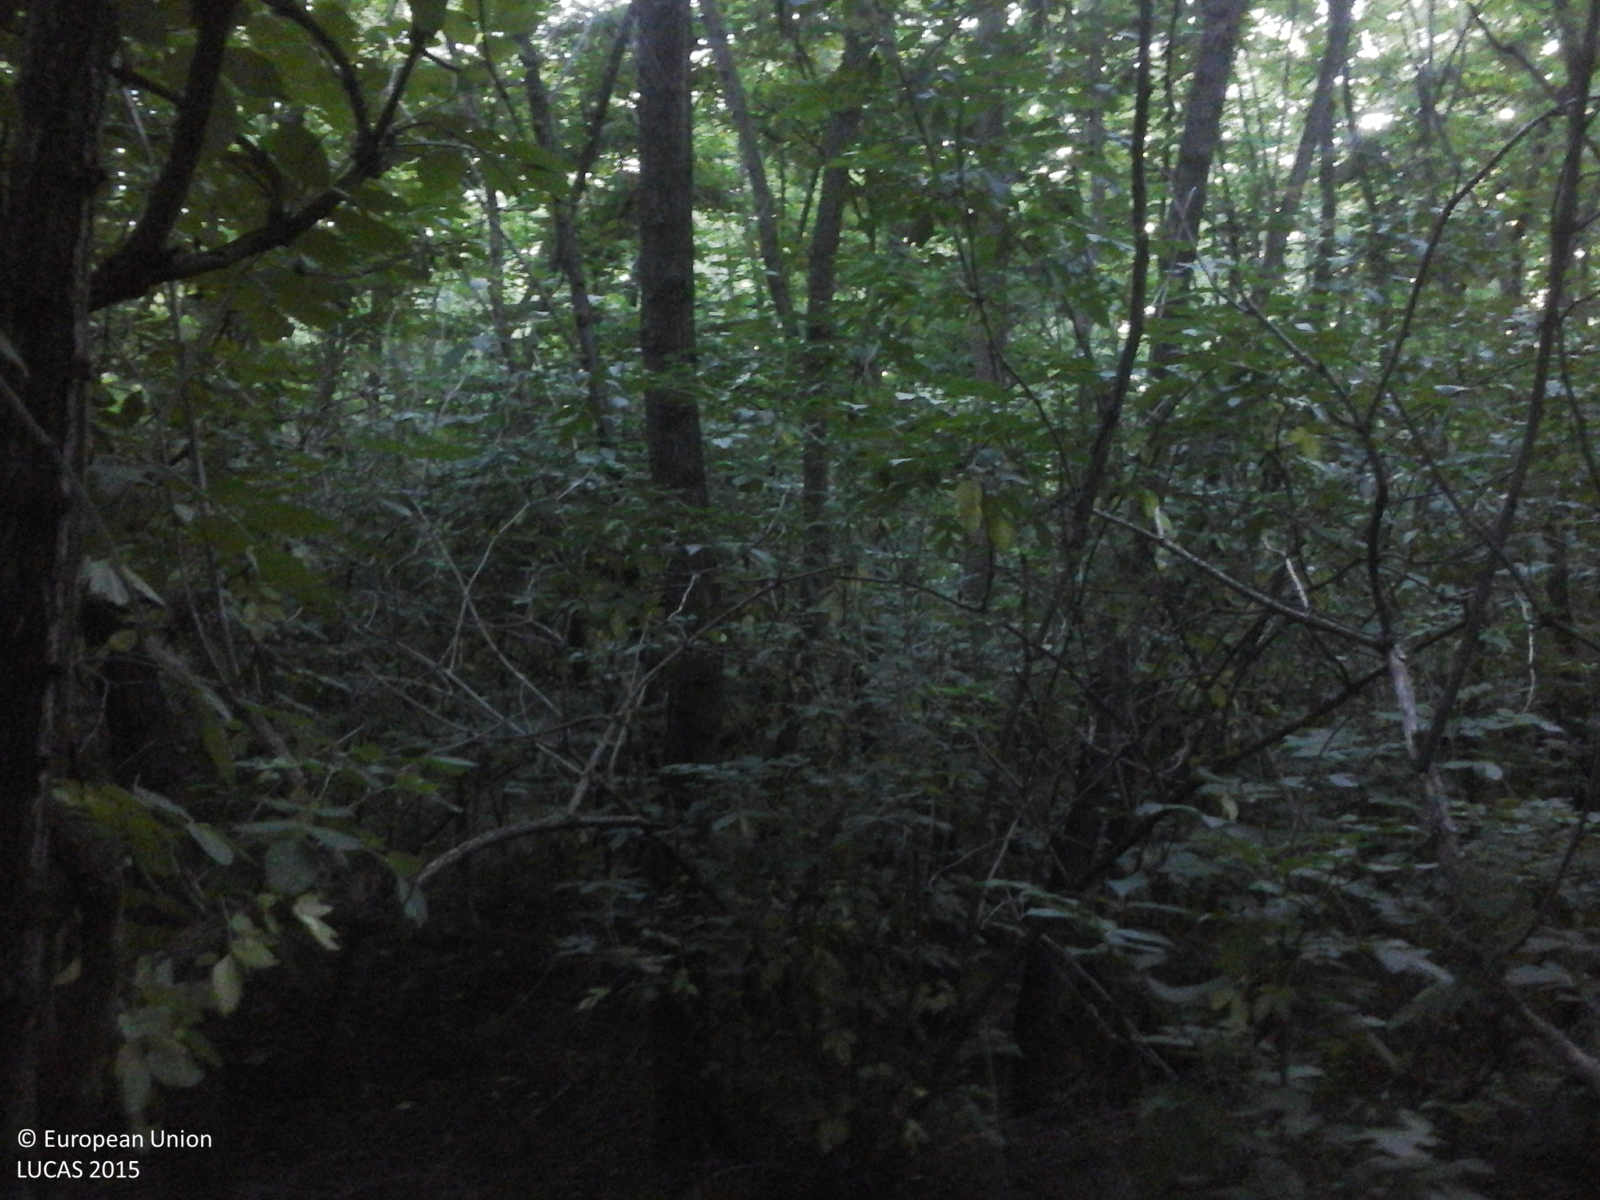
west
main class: Woodland
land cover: Broadleaved woodland
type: exotic forest
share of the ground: > 75 %
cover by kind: broadleaved forest trees 100 %
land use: Forestry
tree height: > 5 m
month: June
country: RO
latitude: 47.6338
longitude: 27.2948
